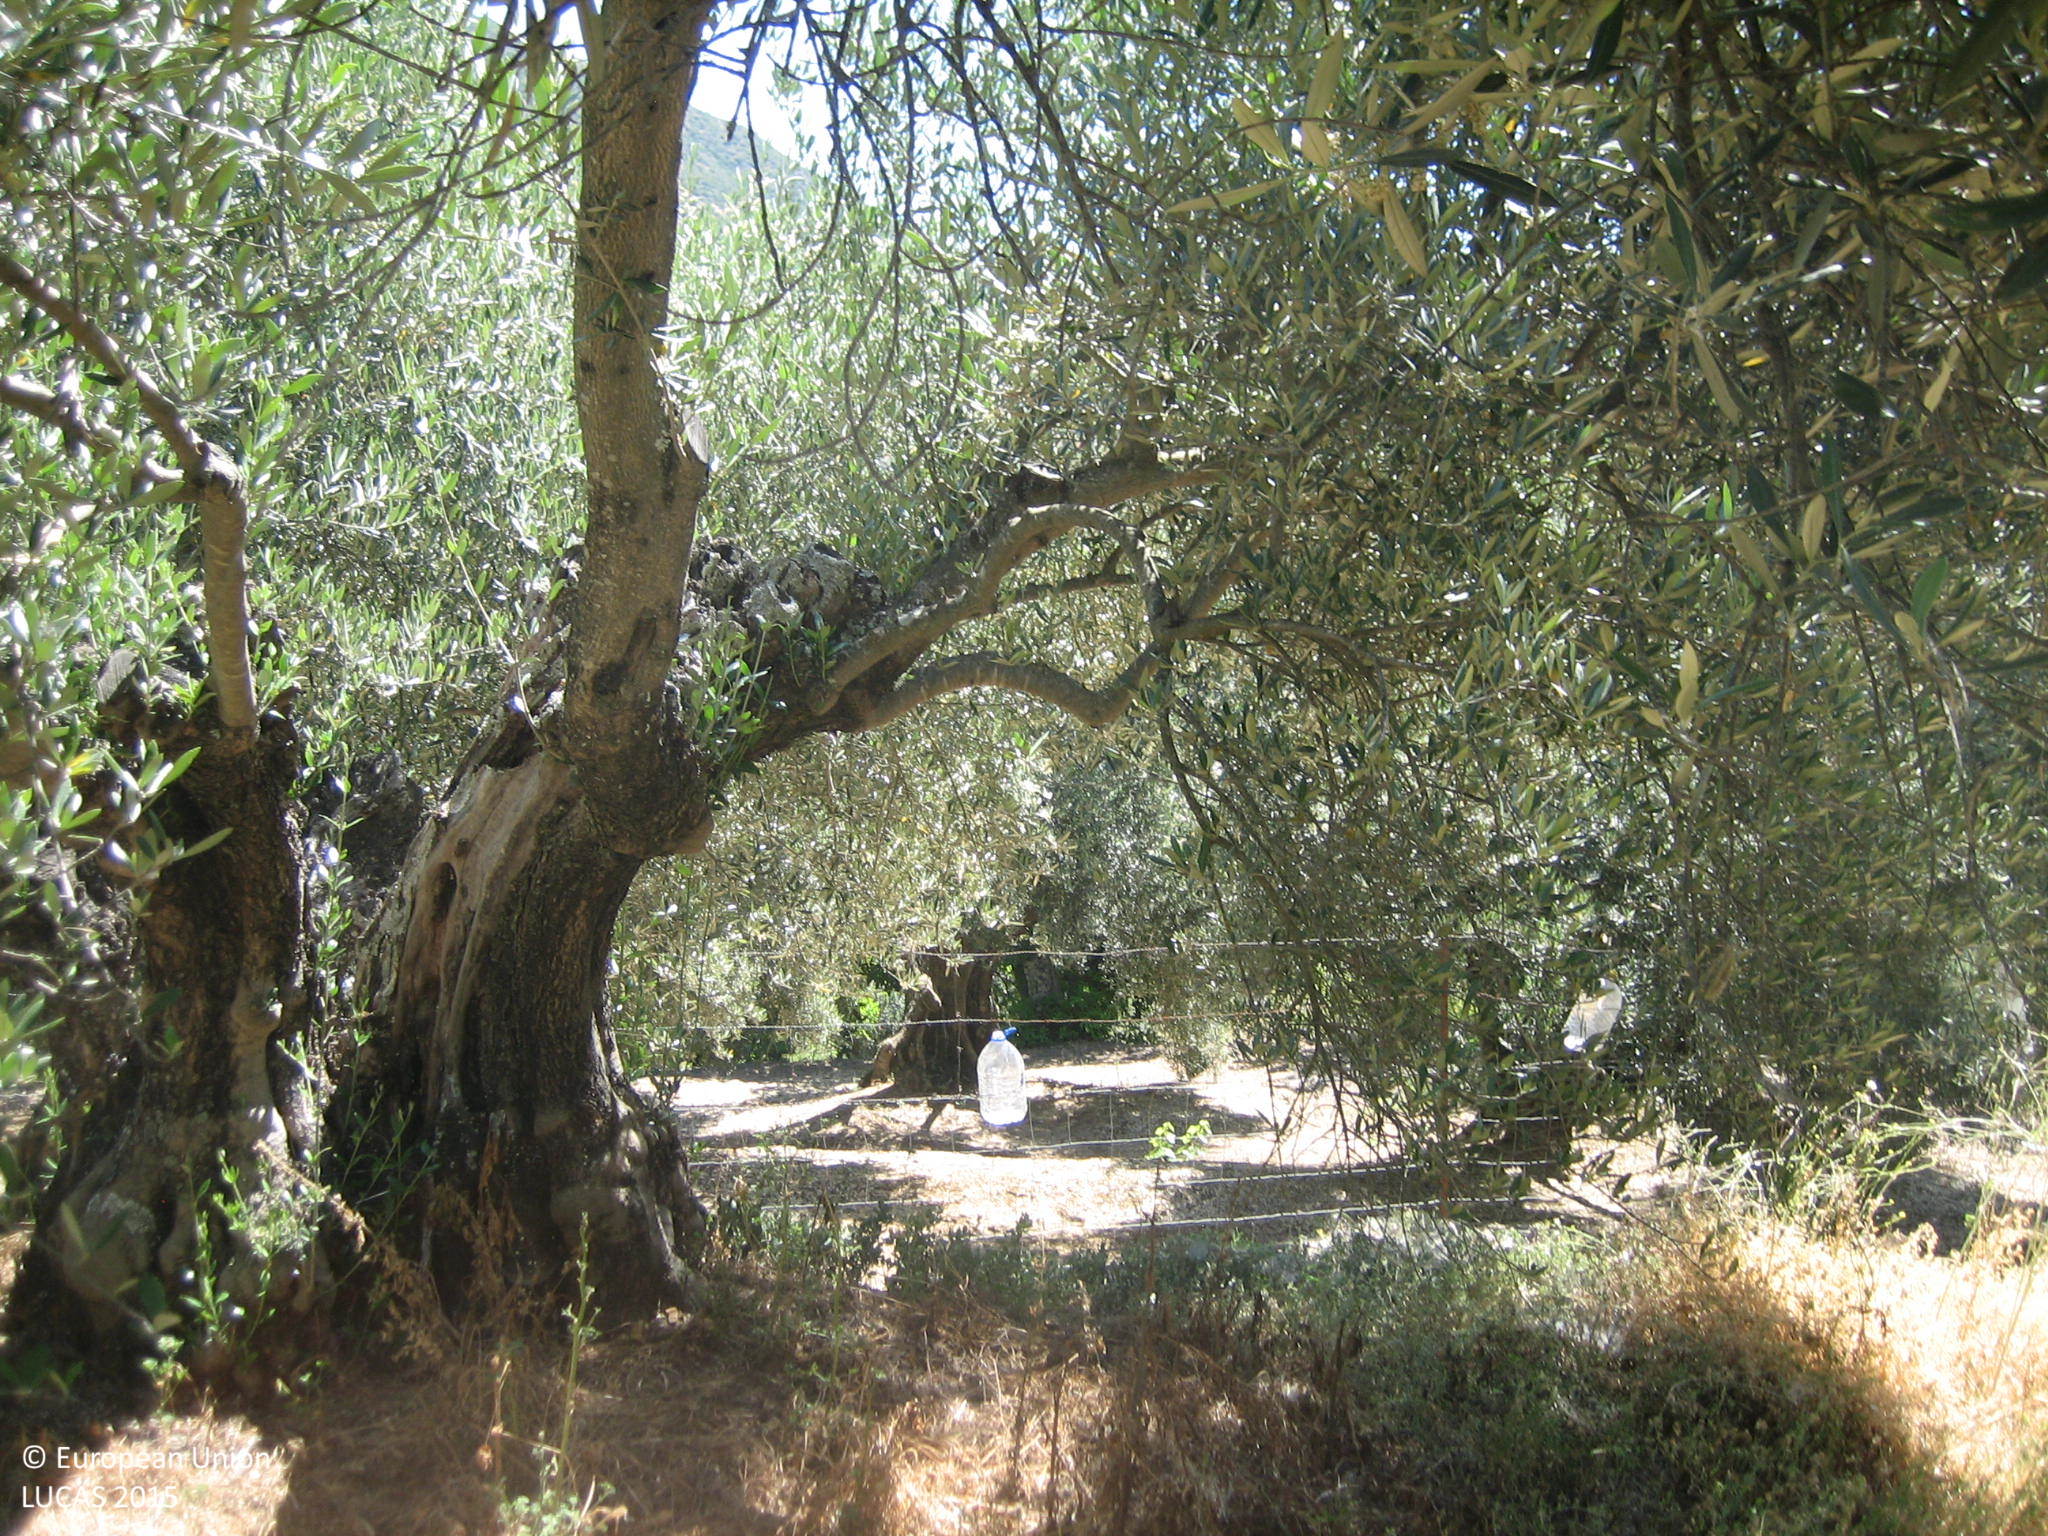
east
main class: Cropland
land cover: Olive groves
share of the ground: 50 - 75 %
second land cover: Grassland without tree/shrub cover
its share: 50 - 75 %
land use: Agriculture (excluding fallow land and kitchen gardens)
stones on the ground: < 10 %
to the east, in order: Olive groves; Grassland without tree/shrub cover; Fences; Olive groves; Fences; Broadleaved woodland; Shrubland with sparse tree cover; Tracks; Shrubland with sparse tree cover
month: May
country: ES
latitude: 38.3857
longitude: -3.9443
